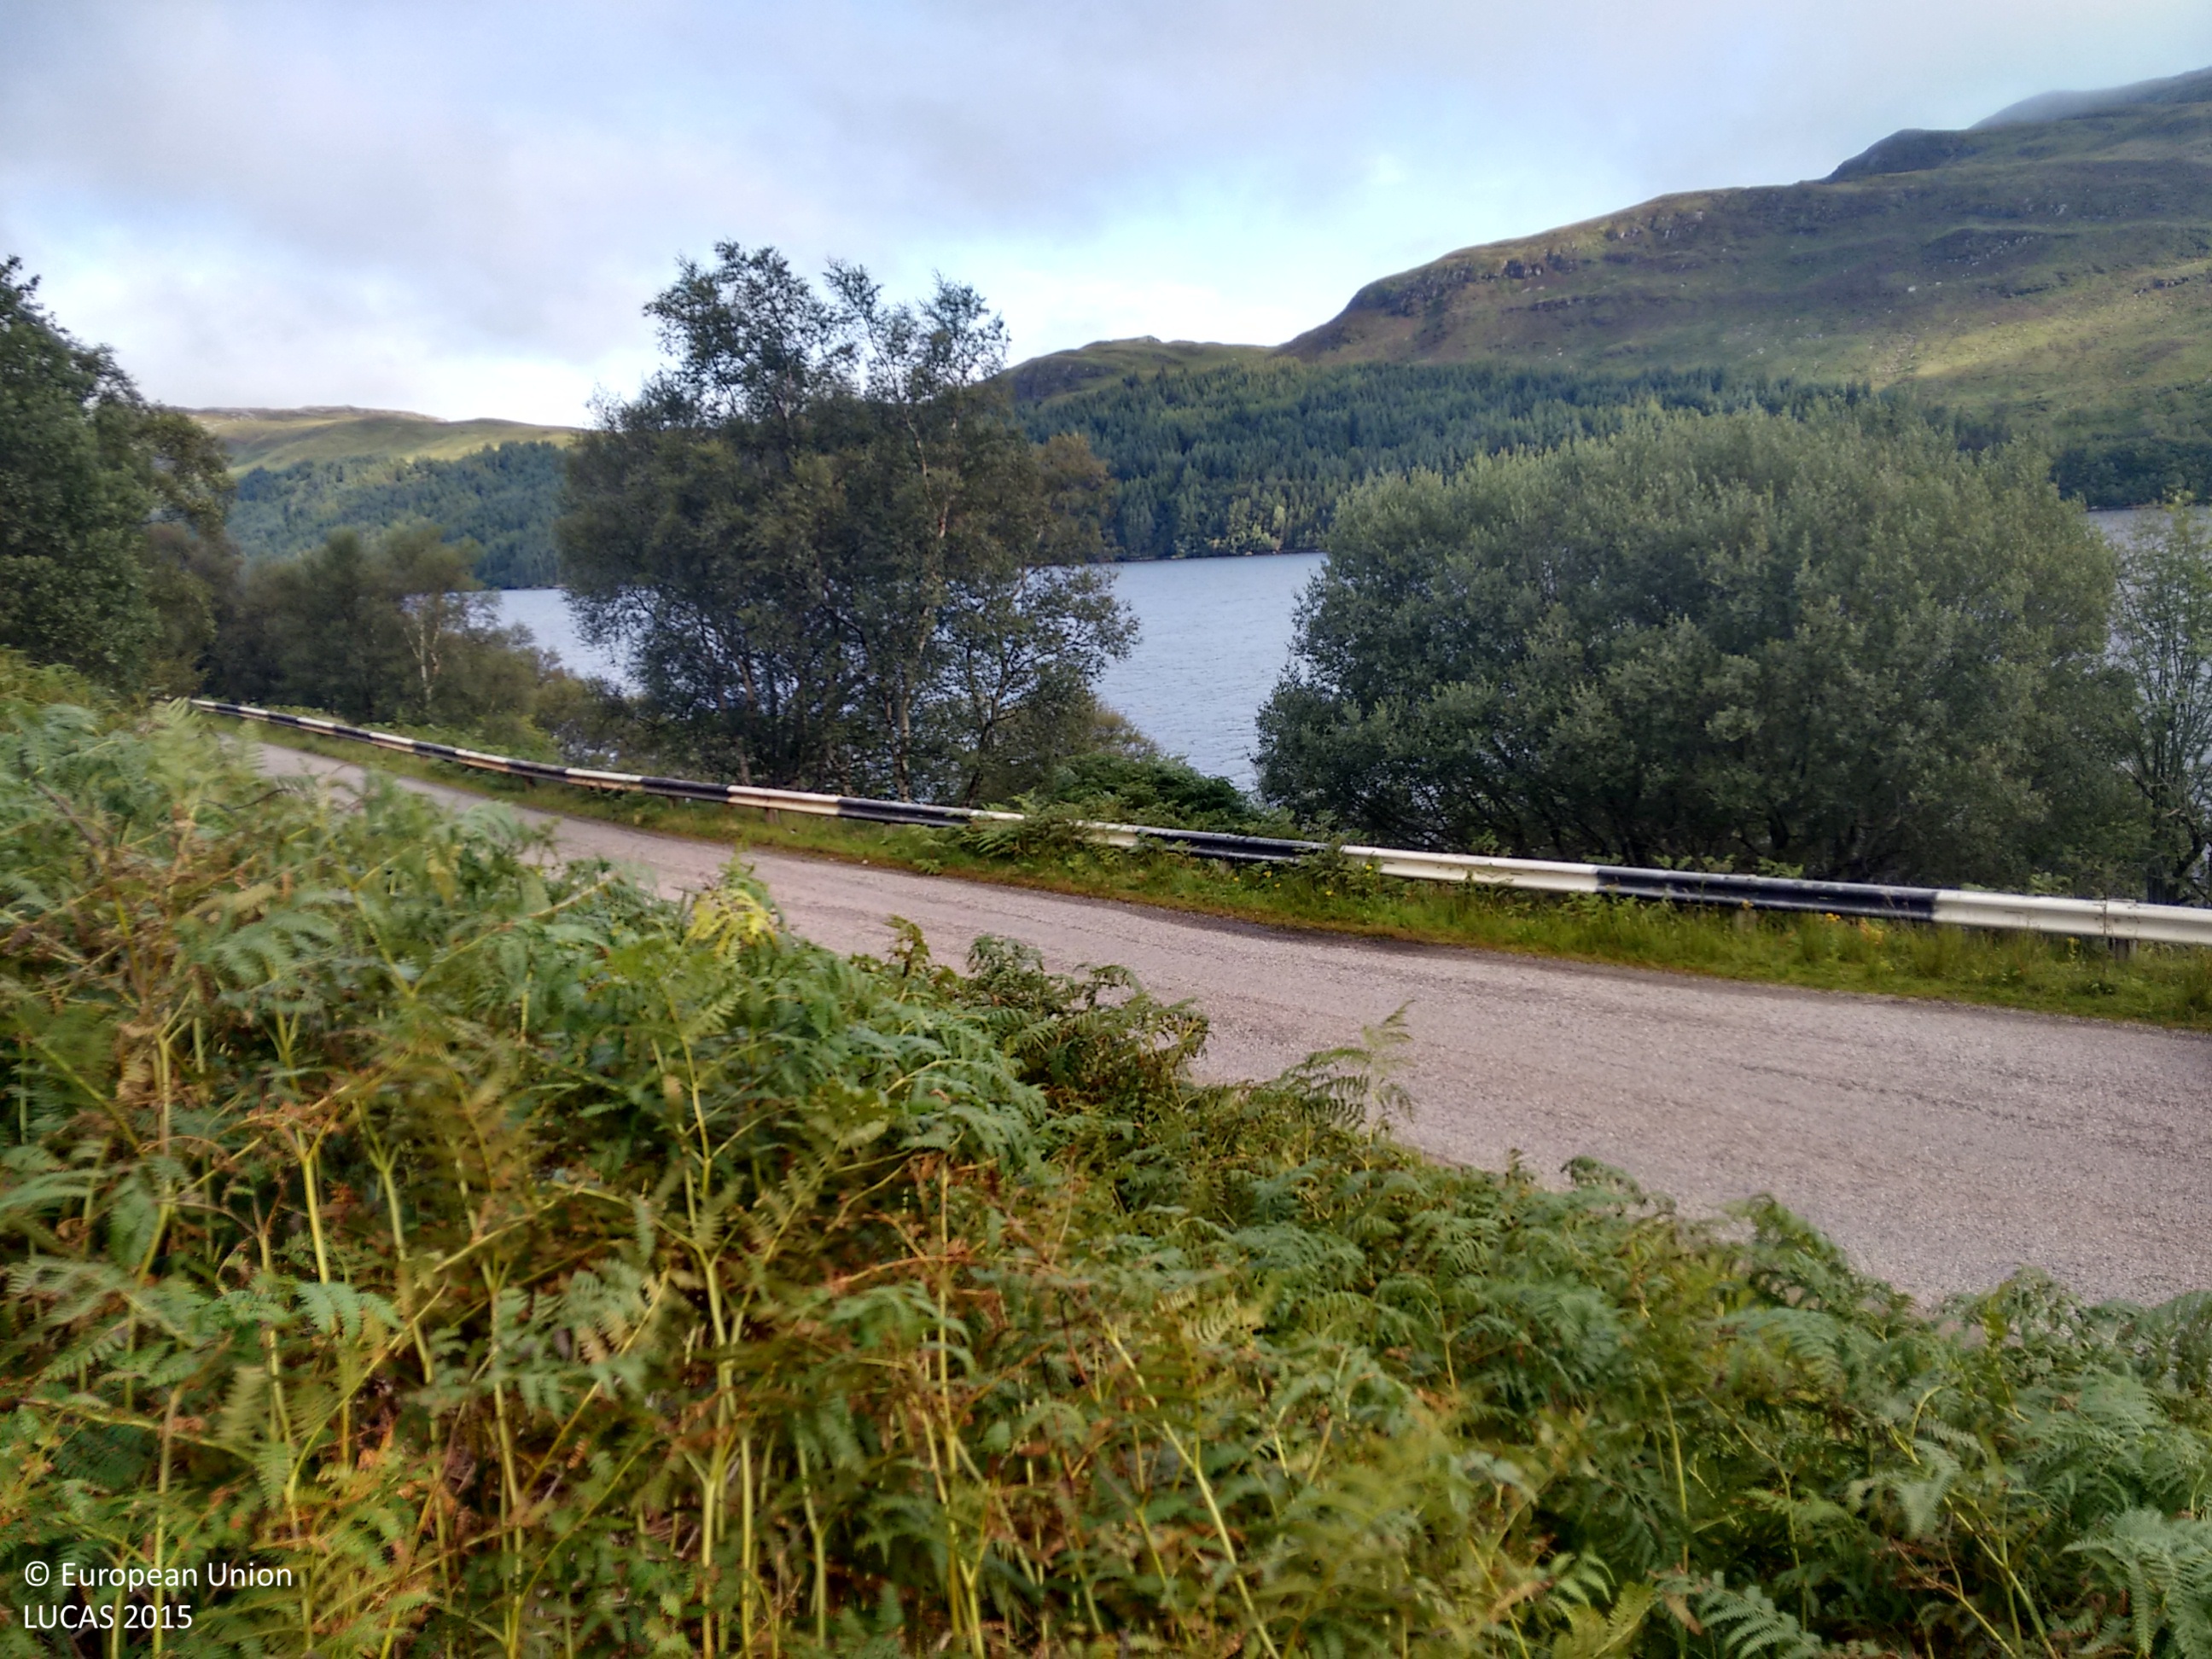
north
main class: Grassland
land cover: Grassland with sparse tree/shrub cover
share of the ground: > 75 %
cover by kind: herbaceous plants 85 %, shrubs 10 %, broadleaved forest trees 5 %
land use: Semi-natural and natural areas not in use
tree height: > 5 m
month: September
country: GB
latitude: 58.2869
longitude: -4.8477
